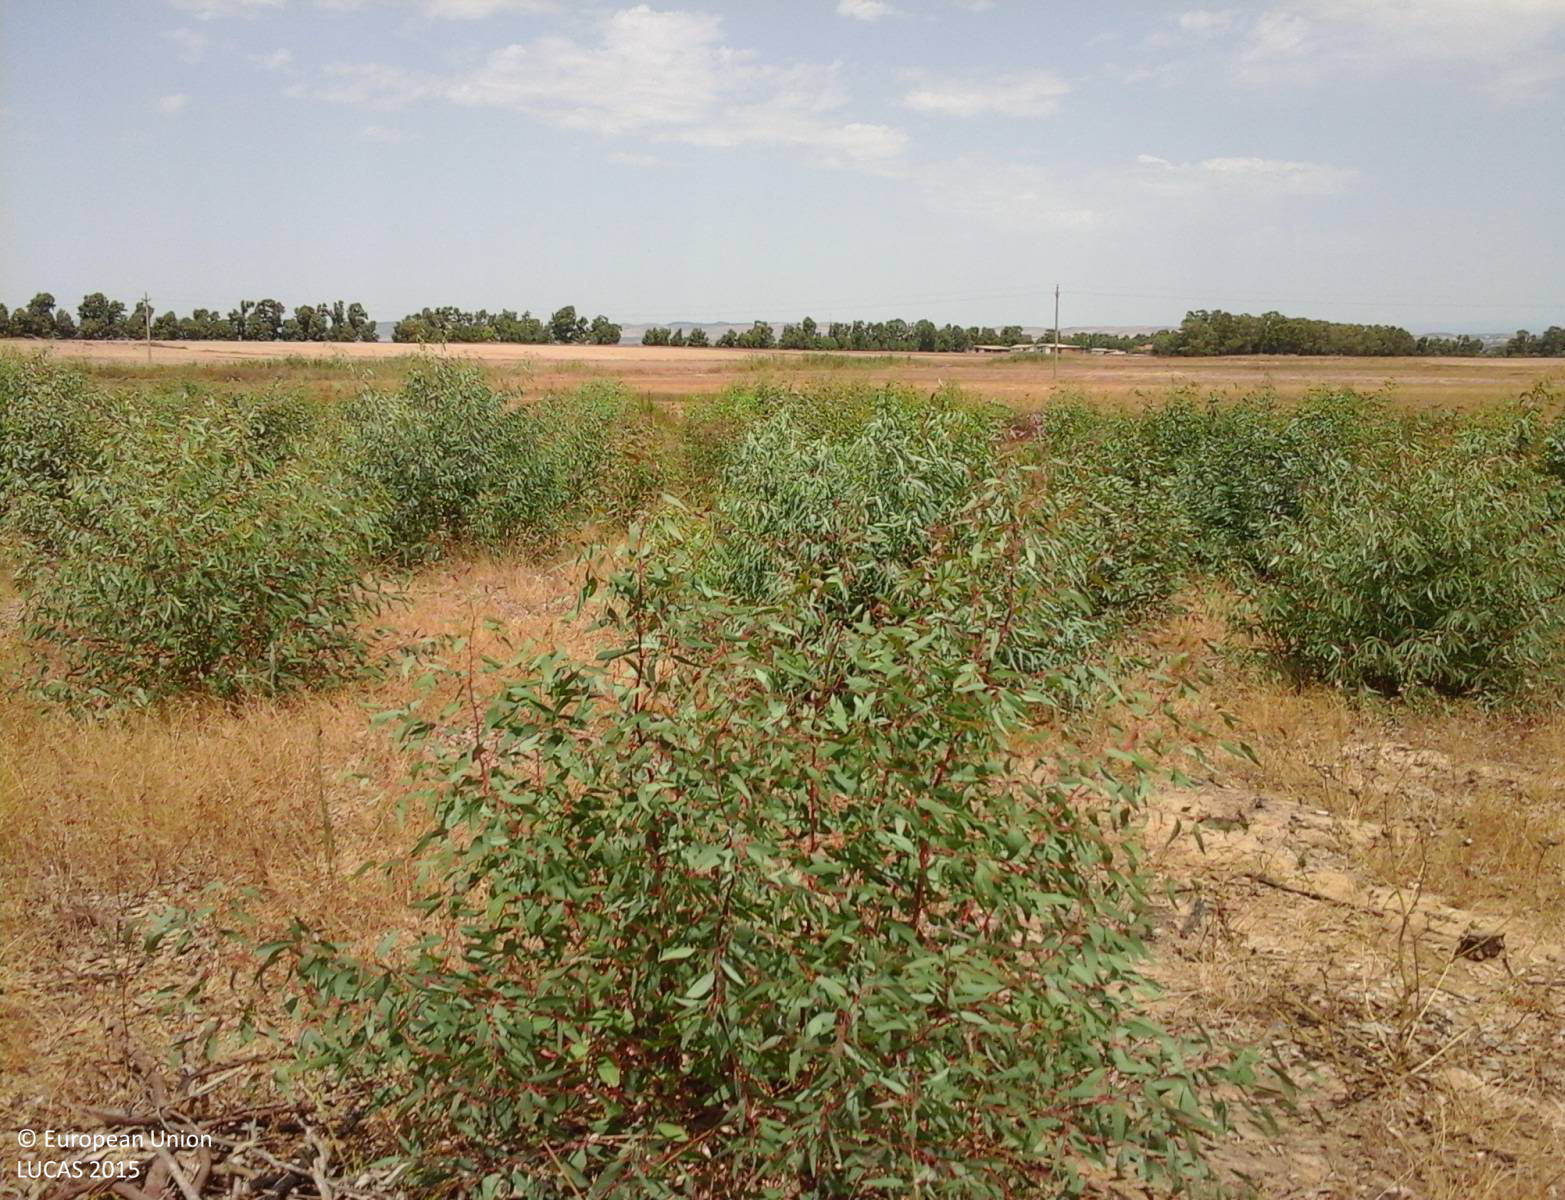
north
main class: Shrubland
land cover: Shrubland without tree cover
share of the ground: > 75 %
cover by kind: shrubs 100 %
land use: Agriculture (excluding fallow land and kitchen gardens)
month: July
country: IT
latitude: 39.4816
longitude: 8.8327
